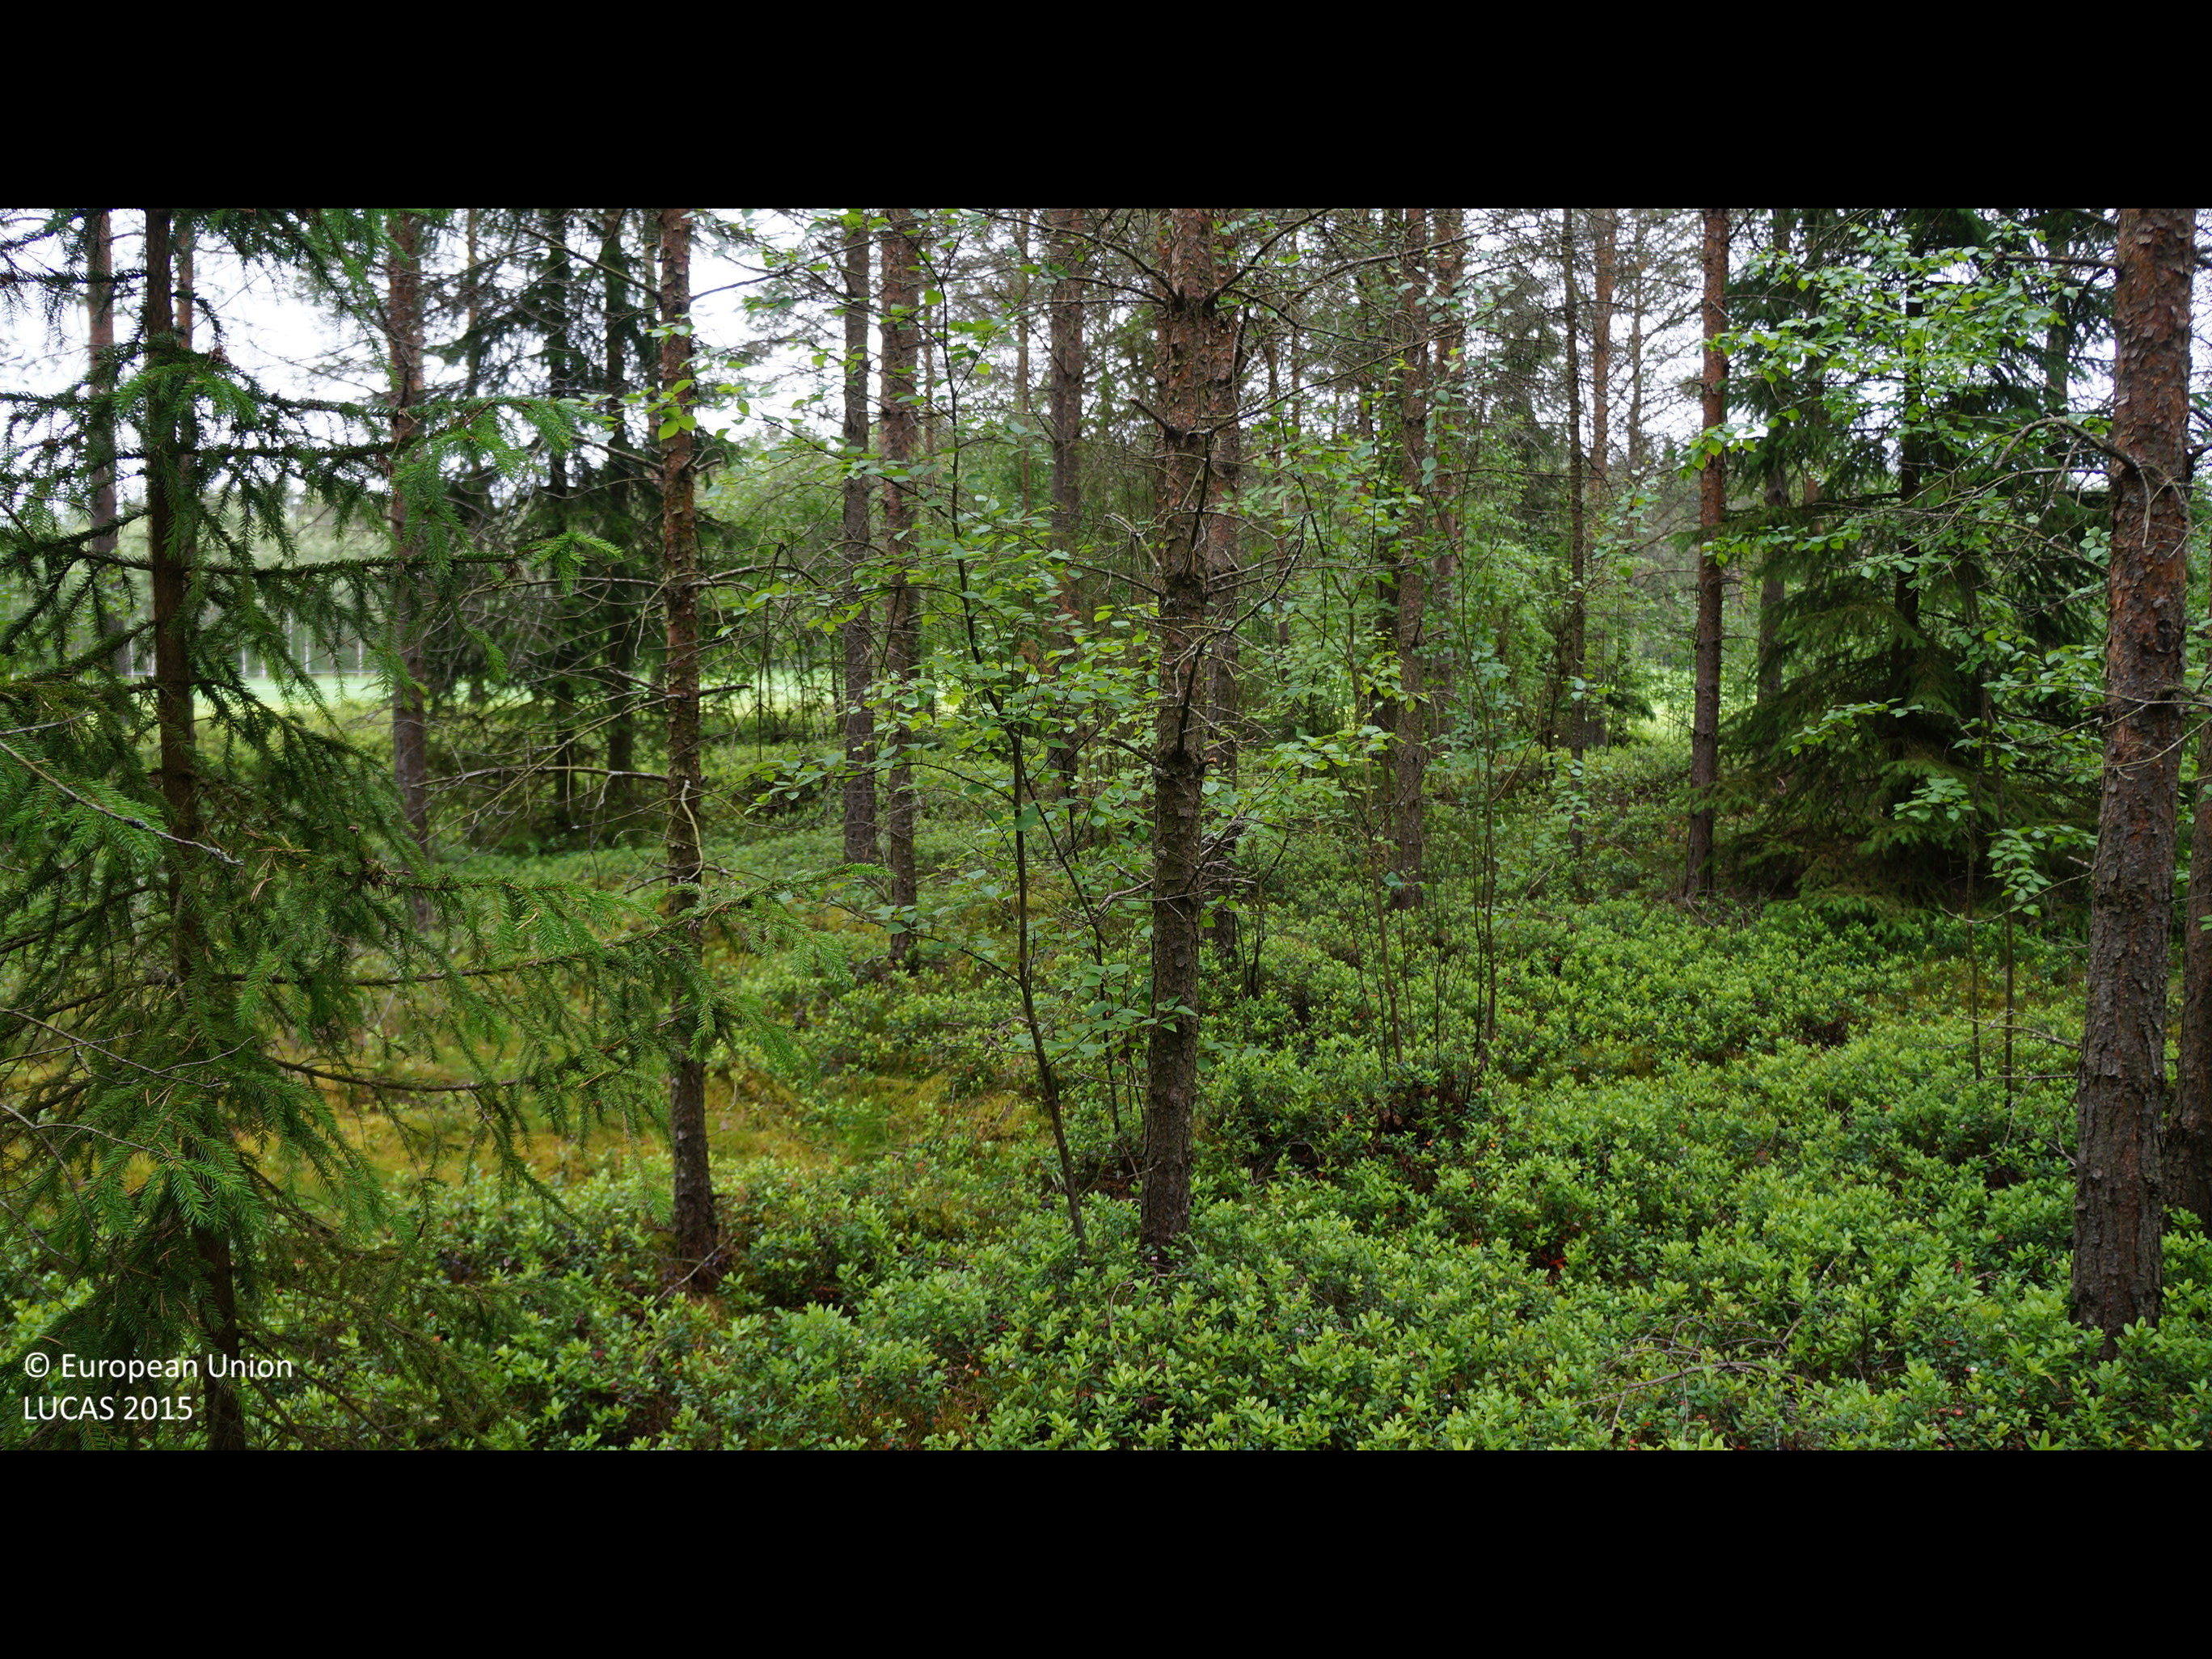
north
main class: Woodland
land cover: Pine dominated coniferous woodland
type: boreal forest
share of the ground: 50 - 75 %
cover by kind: coniferous forest trees 60 %, shrubs 25 %, lichens and mosses 10 %, broadleaved forest trees 5 %
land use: Forestry
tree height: > 5 m
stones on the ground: < 10 %
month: July
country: FI
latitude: 64.0237
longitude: 23.4595
